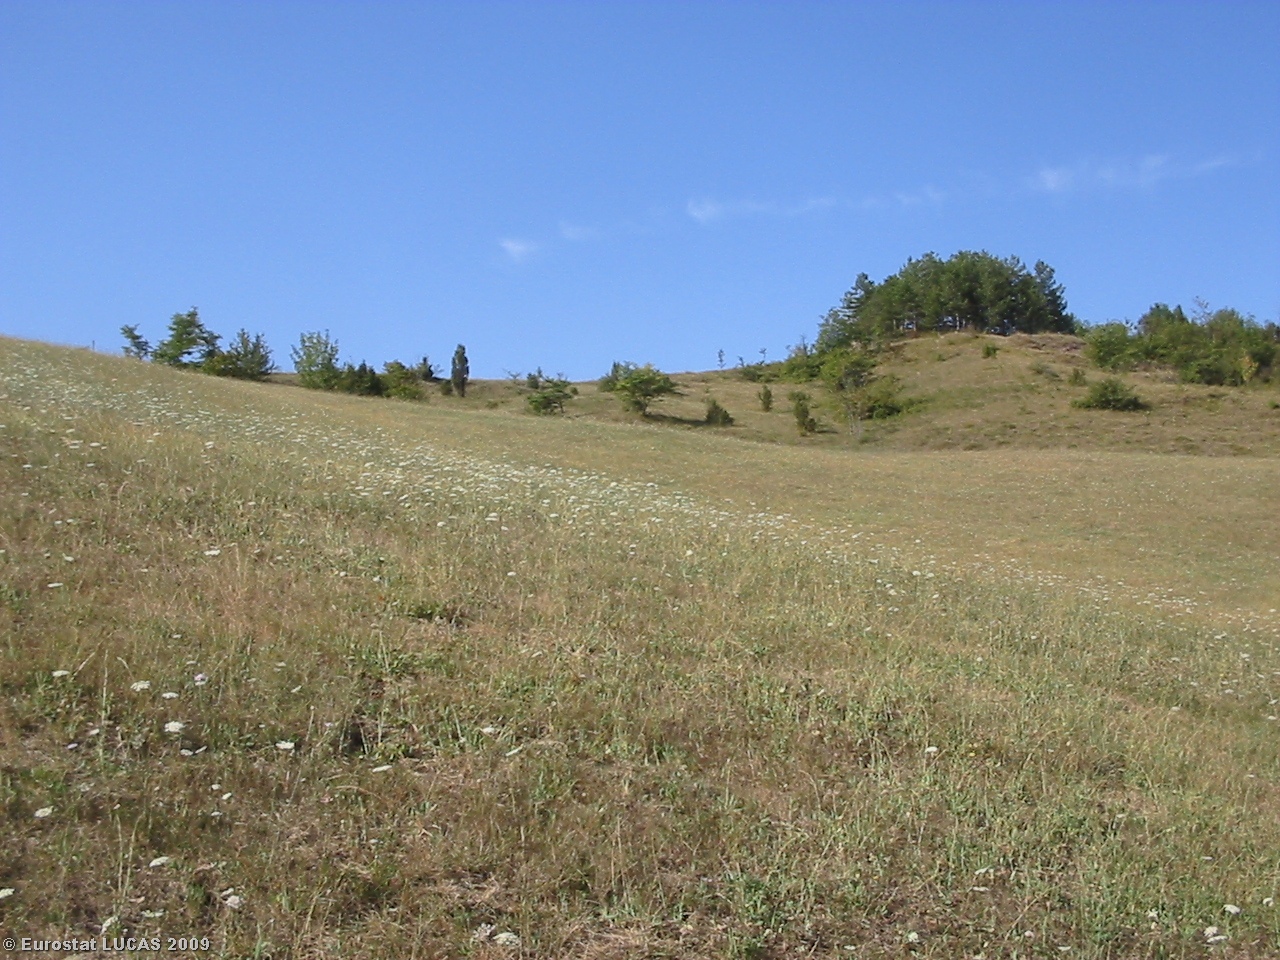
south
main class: Grassland
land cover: Grassland without tree/shrub cover
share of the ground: > 75 %
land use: Agriculture (excluding fallow land and kitchen gardens)
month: July
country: IT
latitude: 44.5484
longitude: 10.3391
